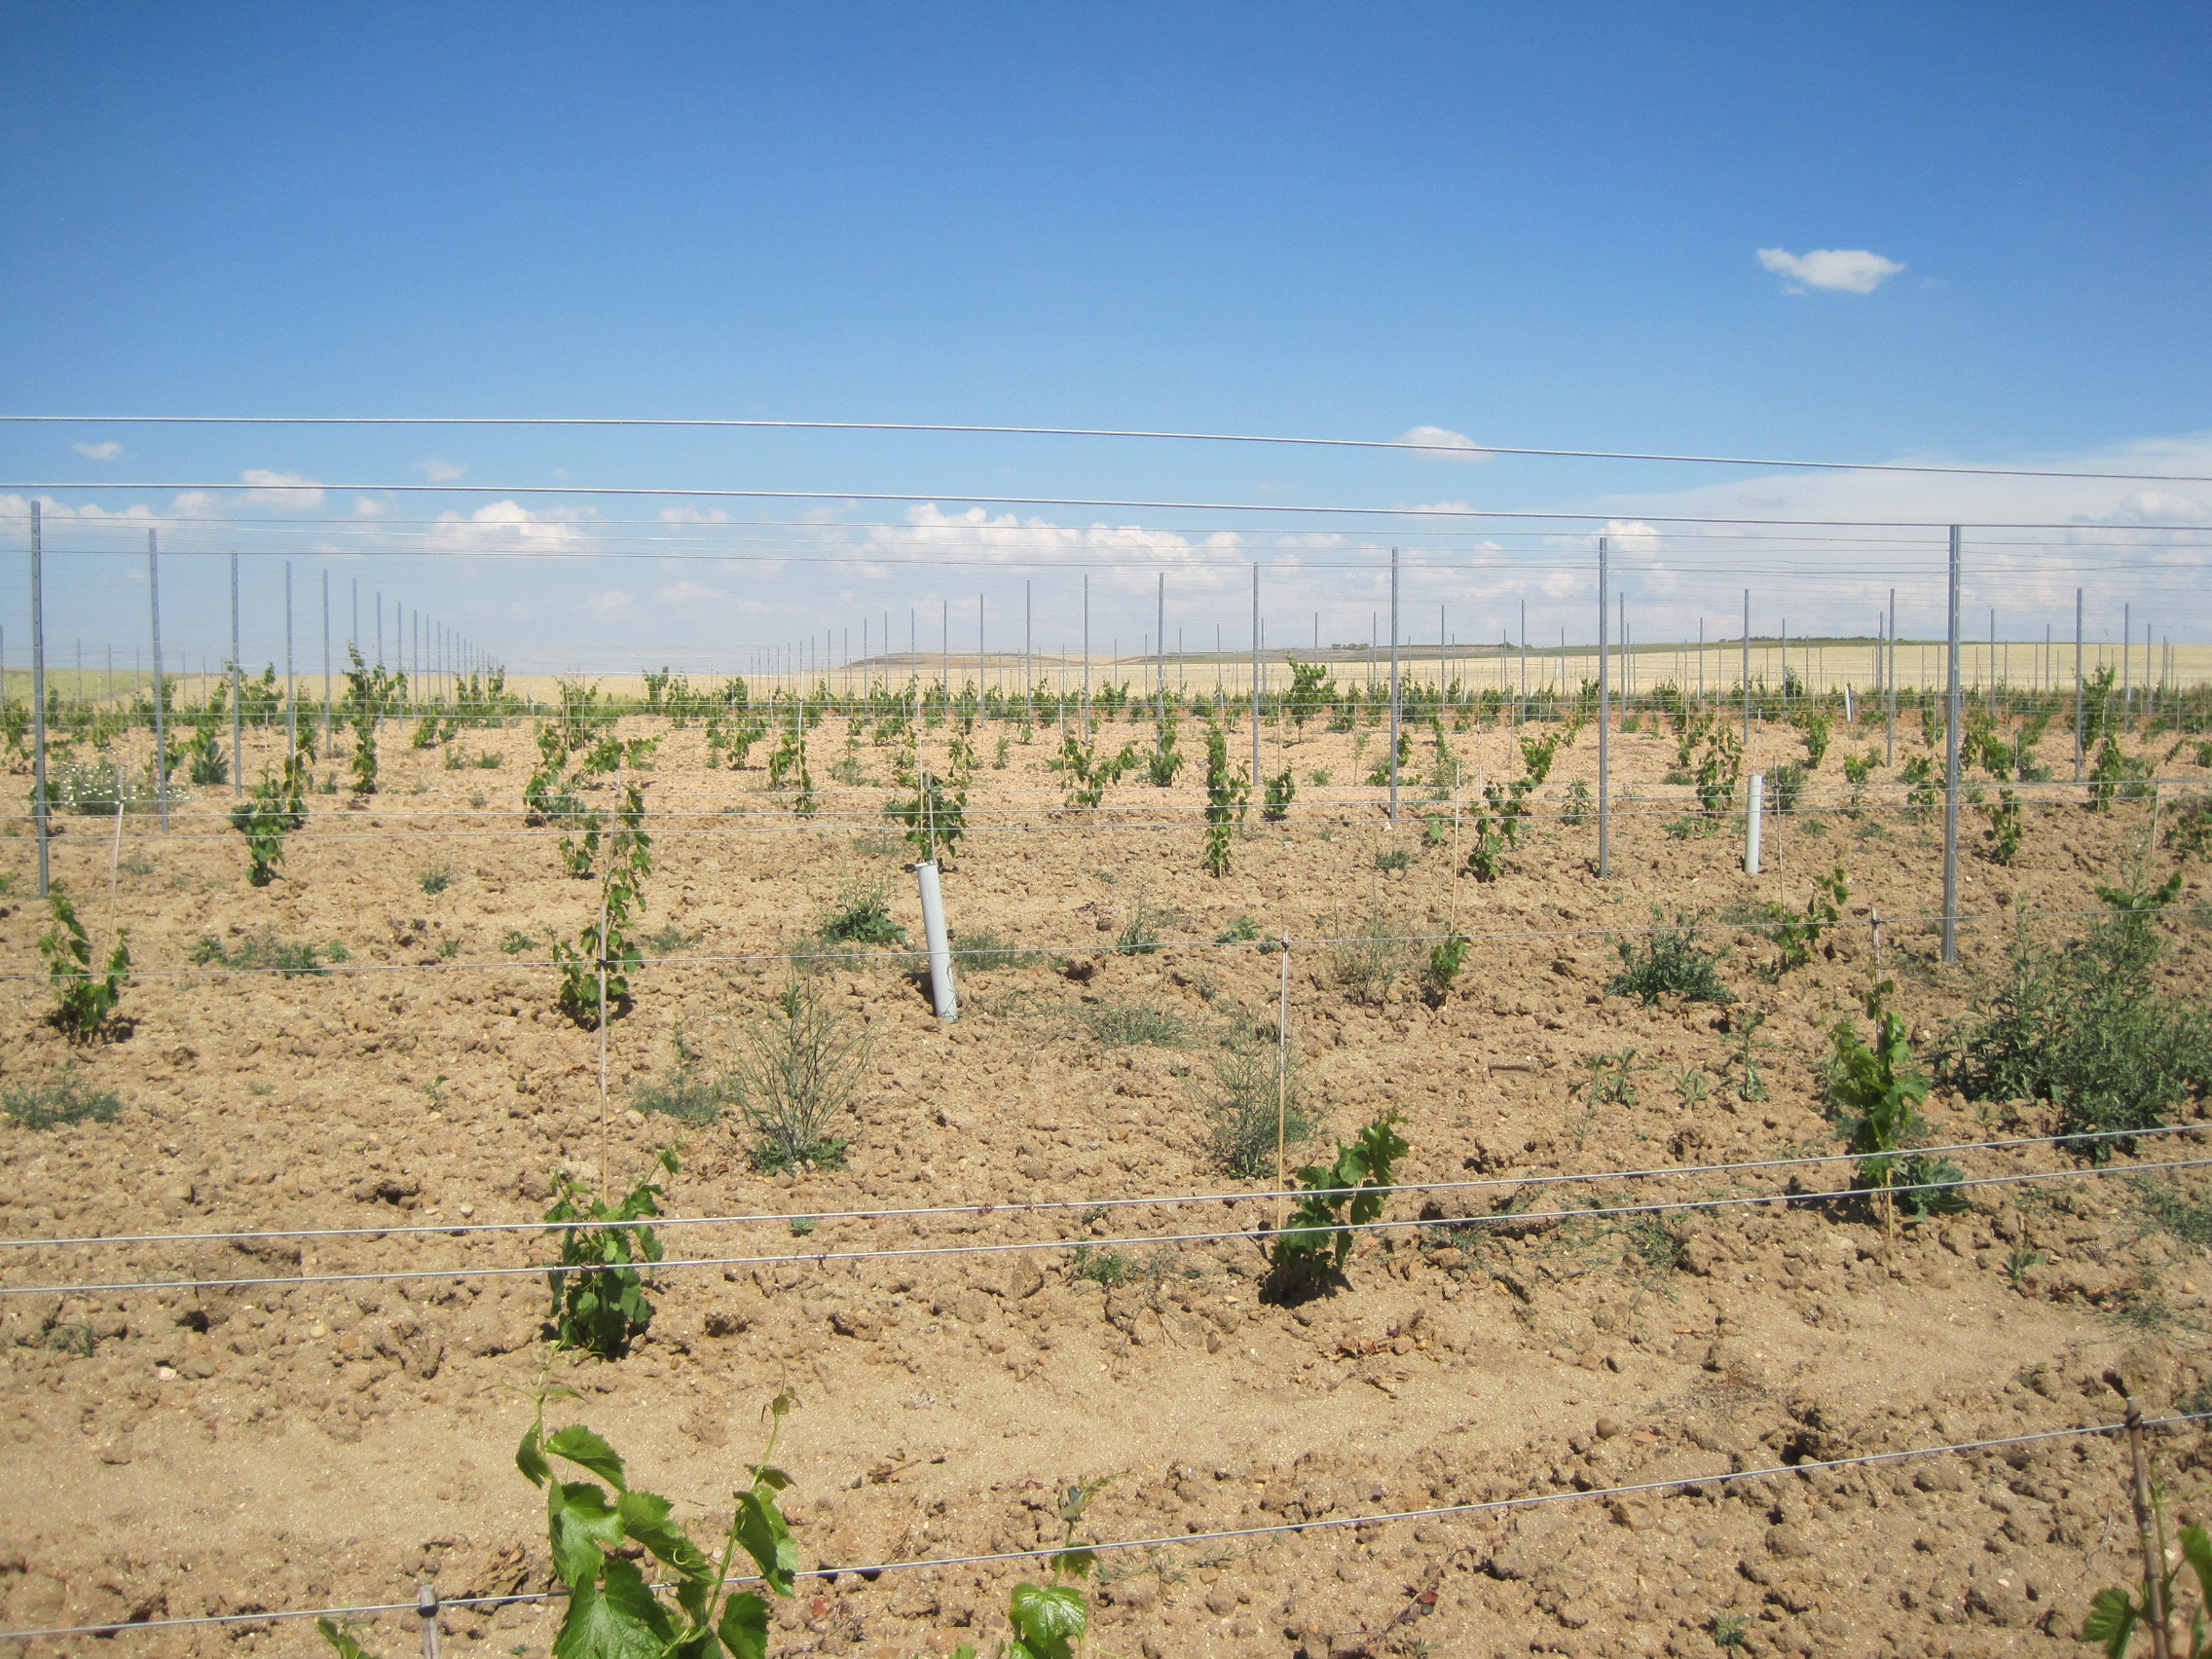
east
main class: Cropland
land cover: Vineyards
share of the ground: 25 - 50 %
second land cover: Other bare soil
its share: > 75 %
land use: Agriculture (excluding fallow land and kitchen gardens)
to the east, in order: Vineyards; Other bare soil; Grass margins; Barley
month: May
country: ES
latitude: 41.3360
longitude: -5.0676
